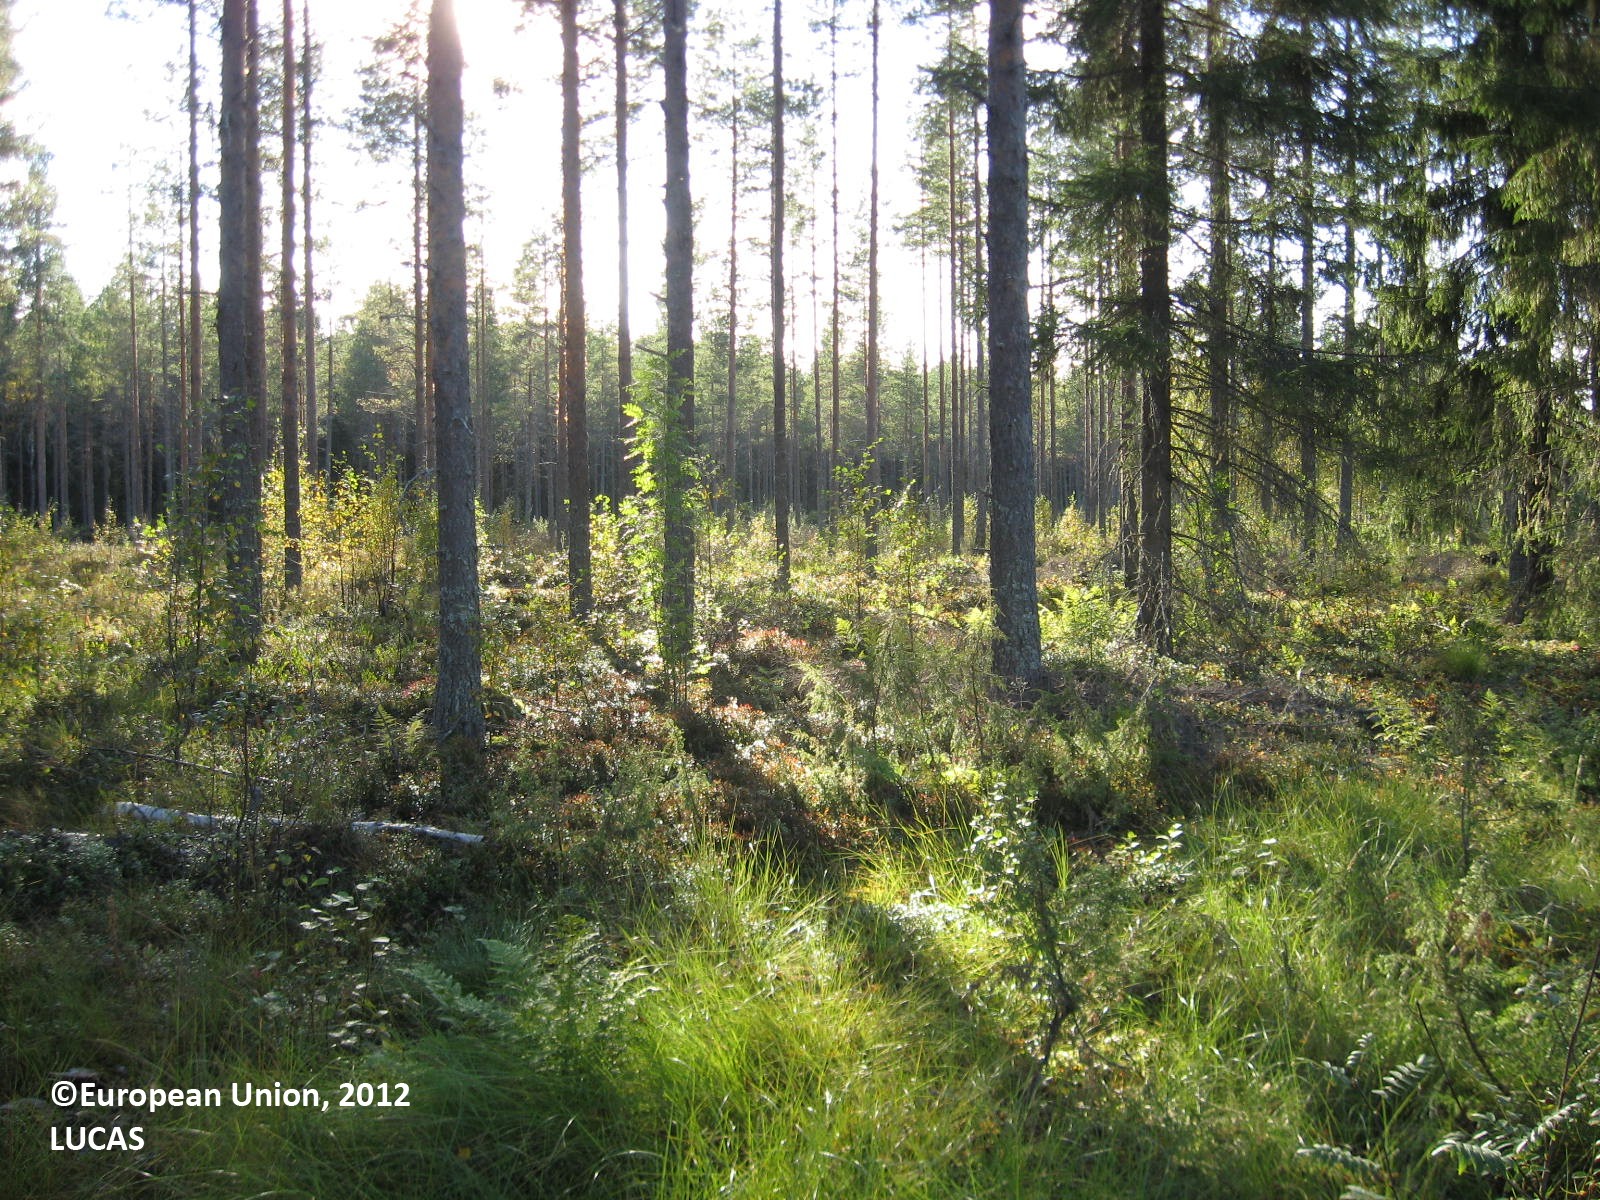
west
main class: Woodland
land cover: Other mixed woodland
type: boreal forest
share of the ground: > 75 %
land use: Forestry
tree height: > 5 m
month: August
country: FI
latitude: 63.9728
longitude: 29.6521
